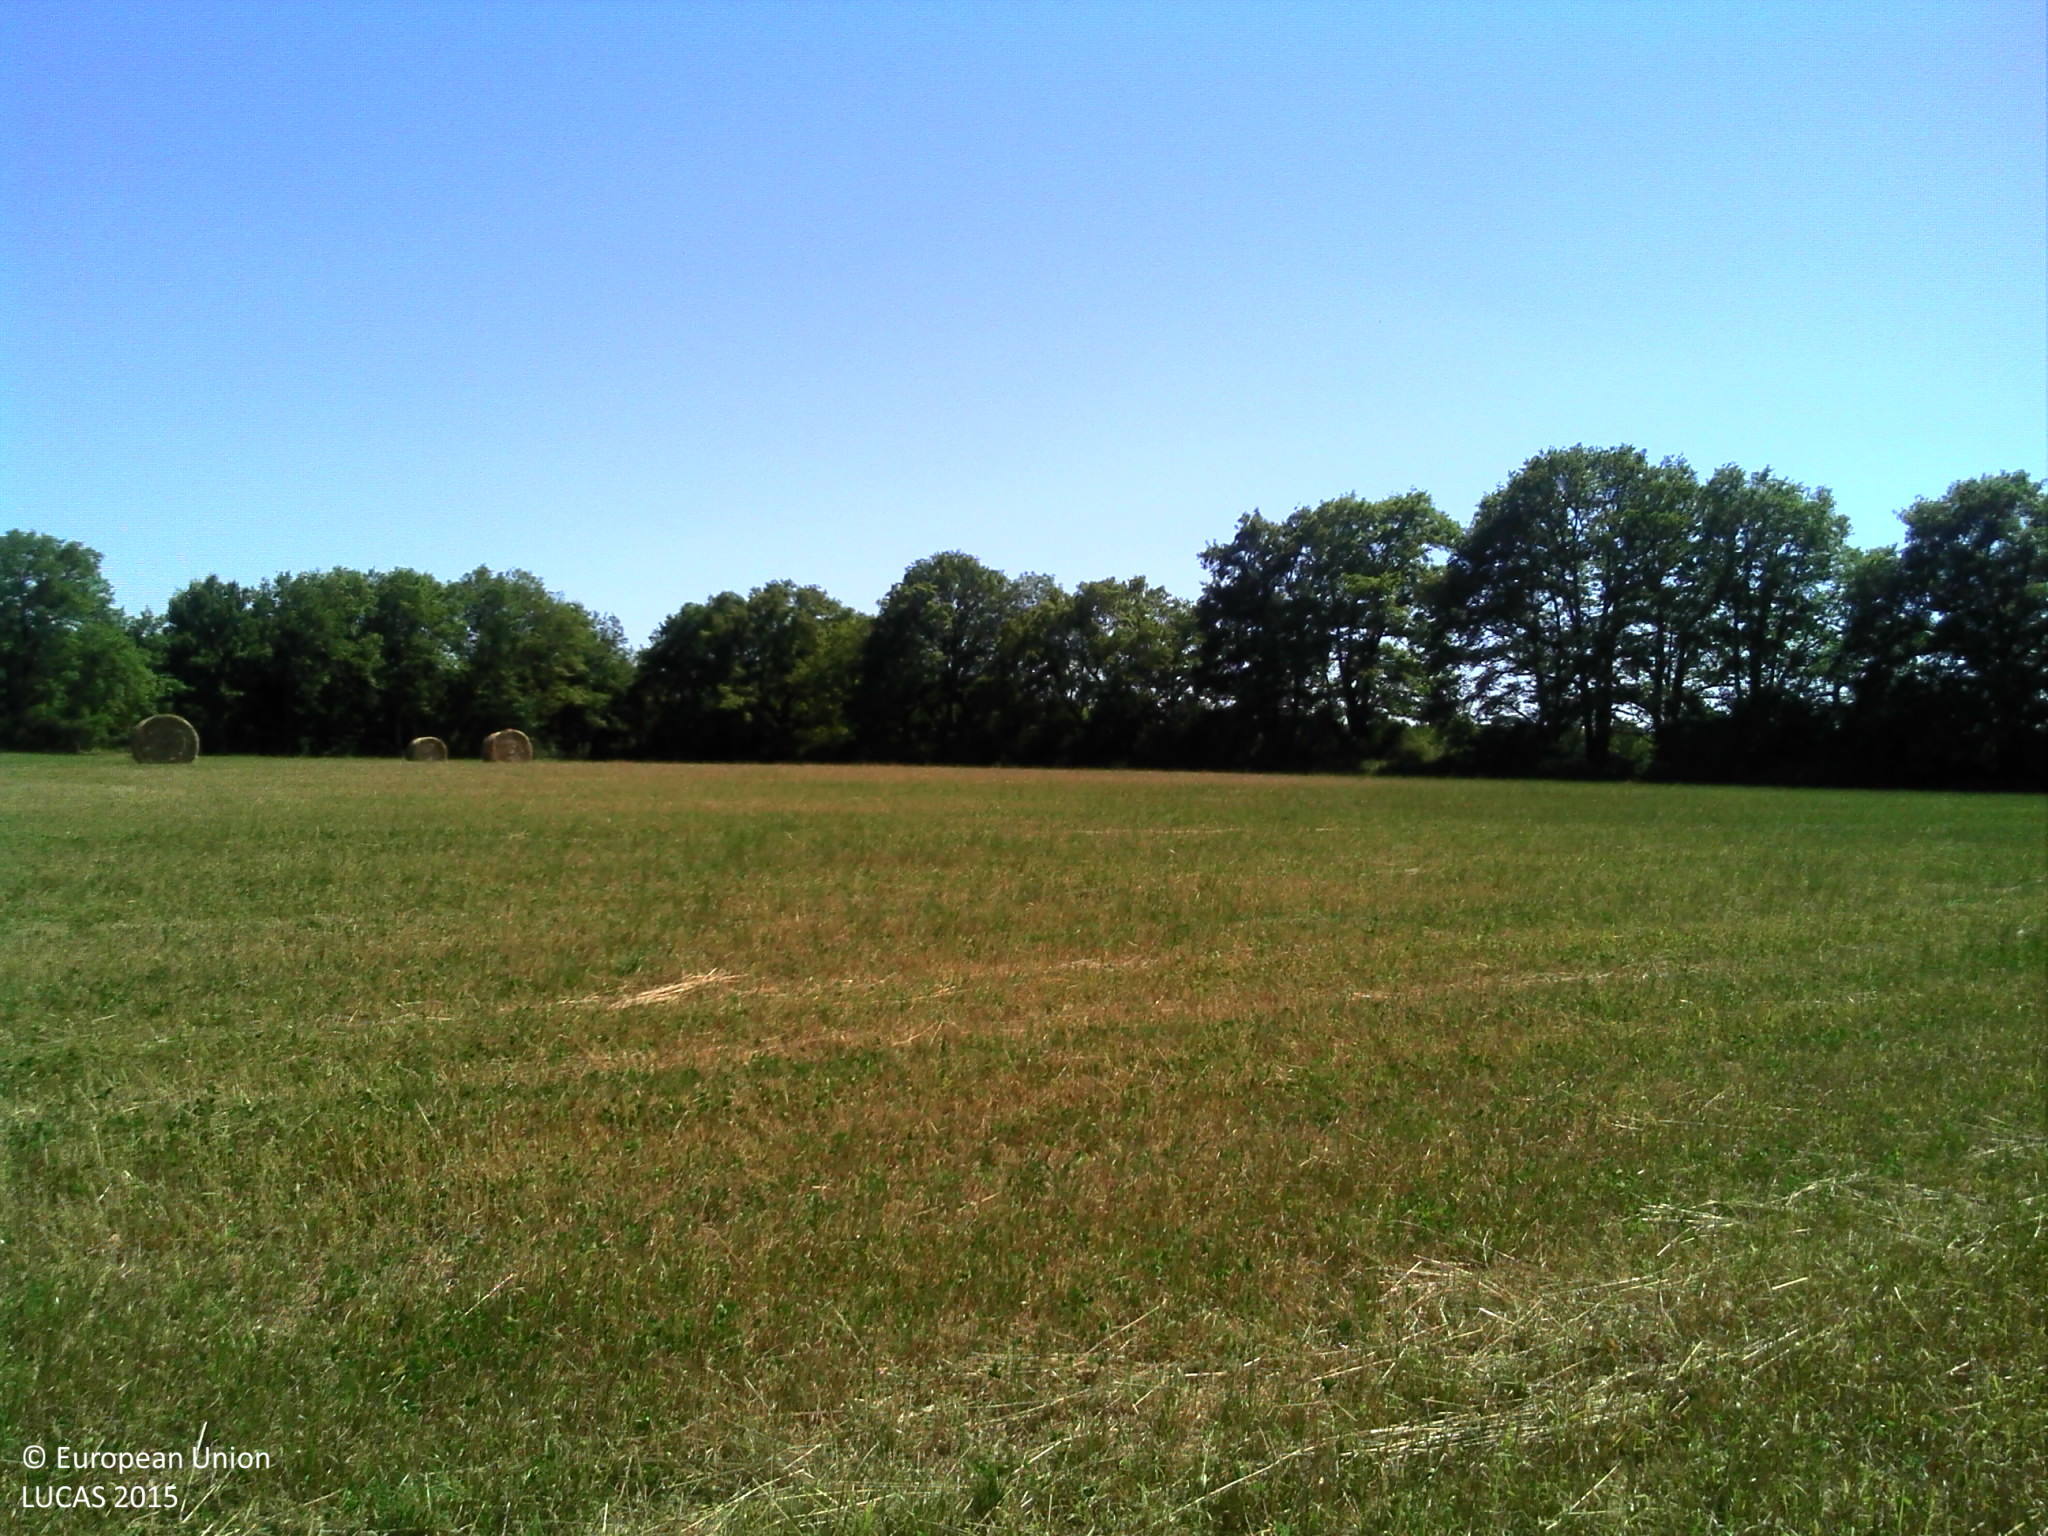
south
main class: Grassland
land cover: Grassland without tree/shrub cover
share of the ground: > 75 %
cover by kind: herbaceous plants 100 %
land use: Agriculture (excluding fallow land and kitchen gardens)
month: June
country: FR
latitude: 47.6494
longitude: 2.8709
